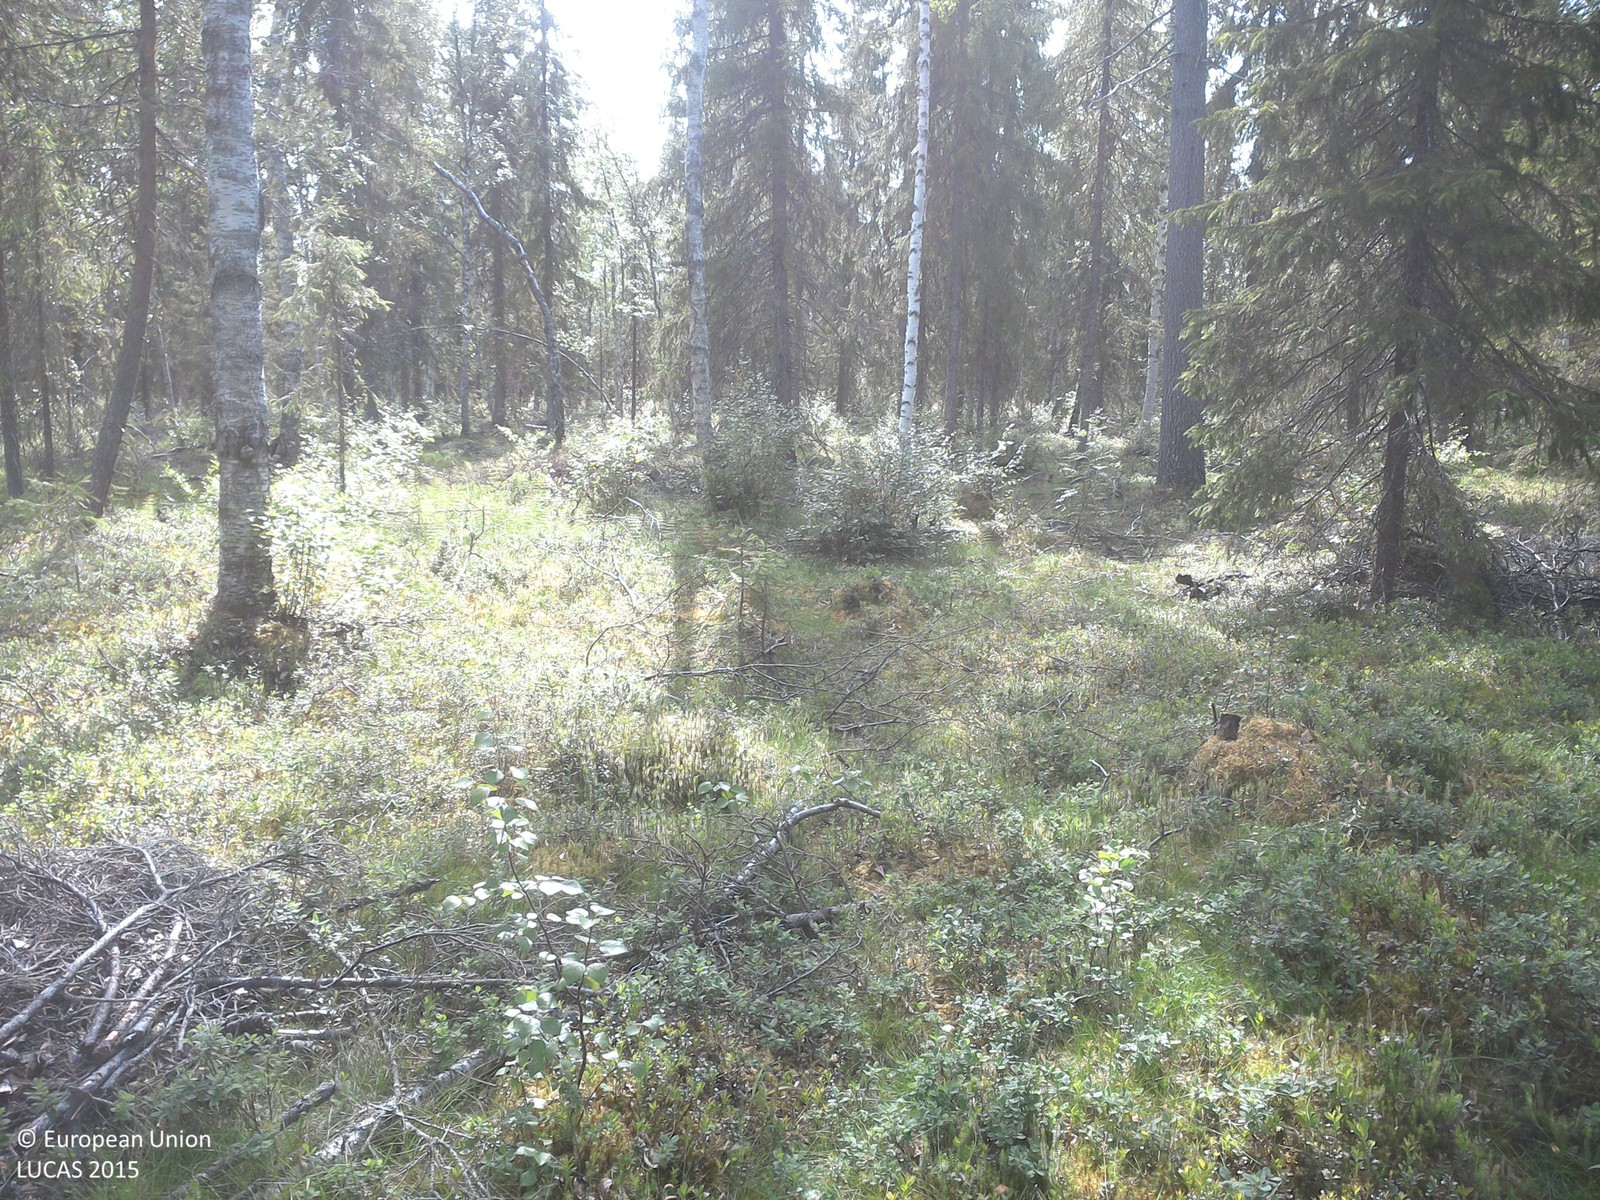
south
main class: Woodland
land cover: Spruce dominated mixed woodland
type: boreal forest
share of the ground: 25 - 50 %
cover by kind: shrubs 45 %, coniferous forest trees 25 %, broadleaved forest trees 10 %, herbaceous plants 10 %, lichens and mosses 10 %
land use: Forestry
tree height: > 5 m
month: July
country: SE
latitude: 67.5237
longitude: 23.4459
